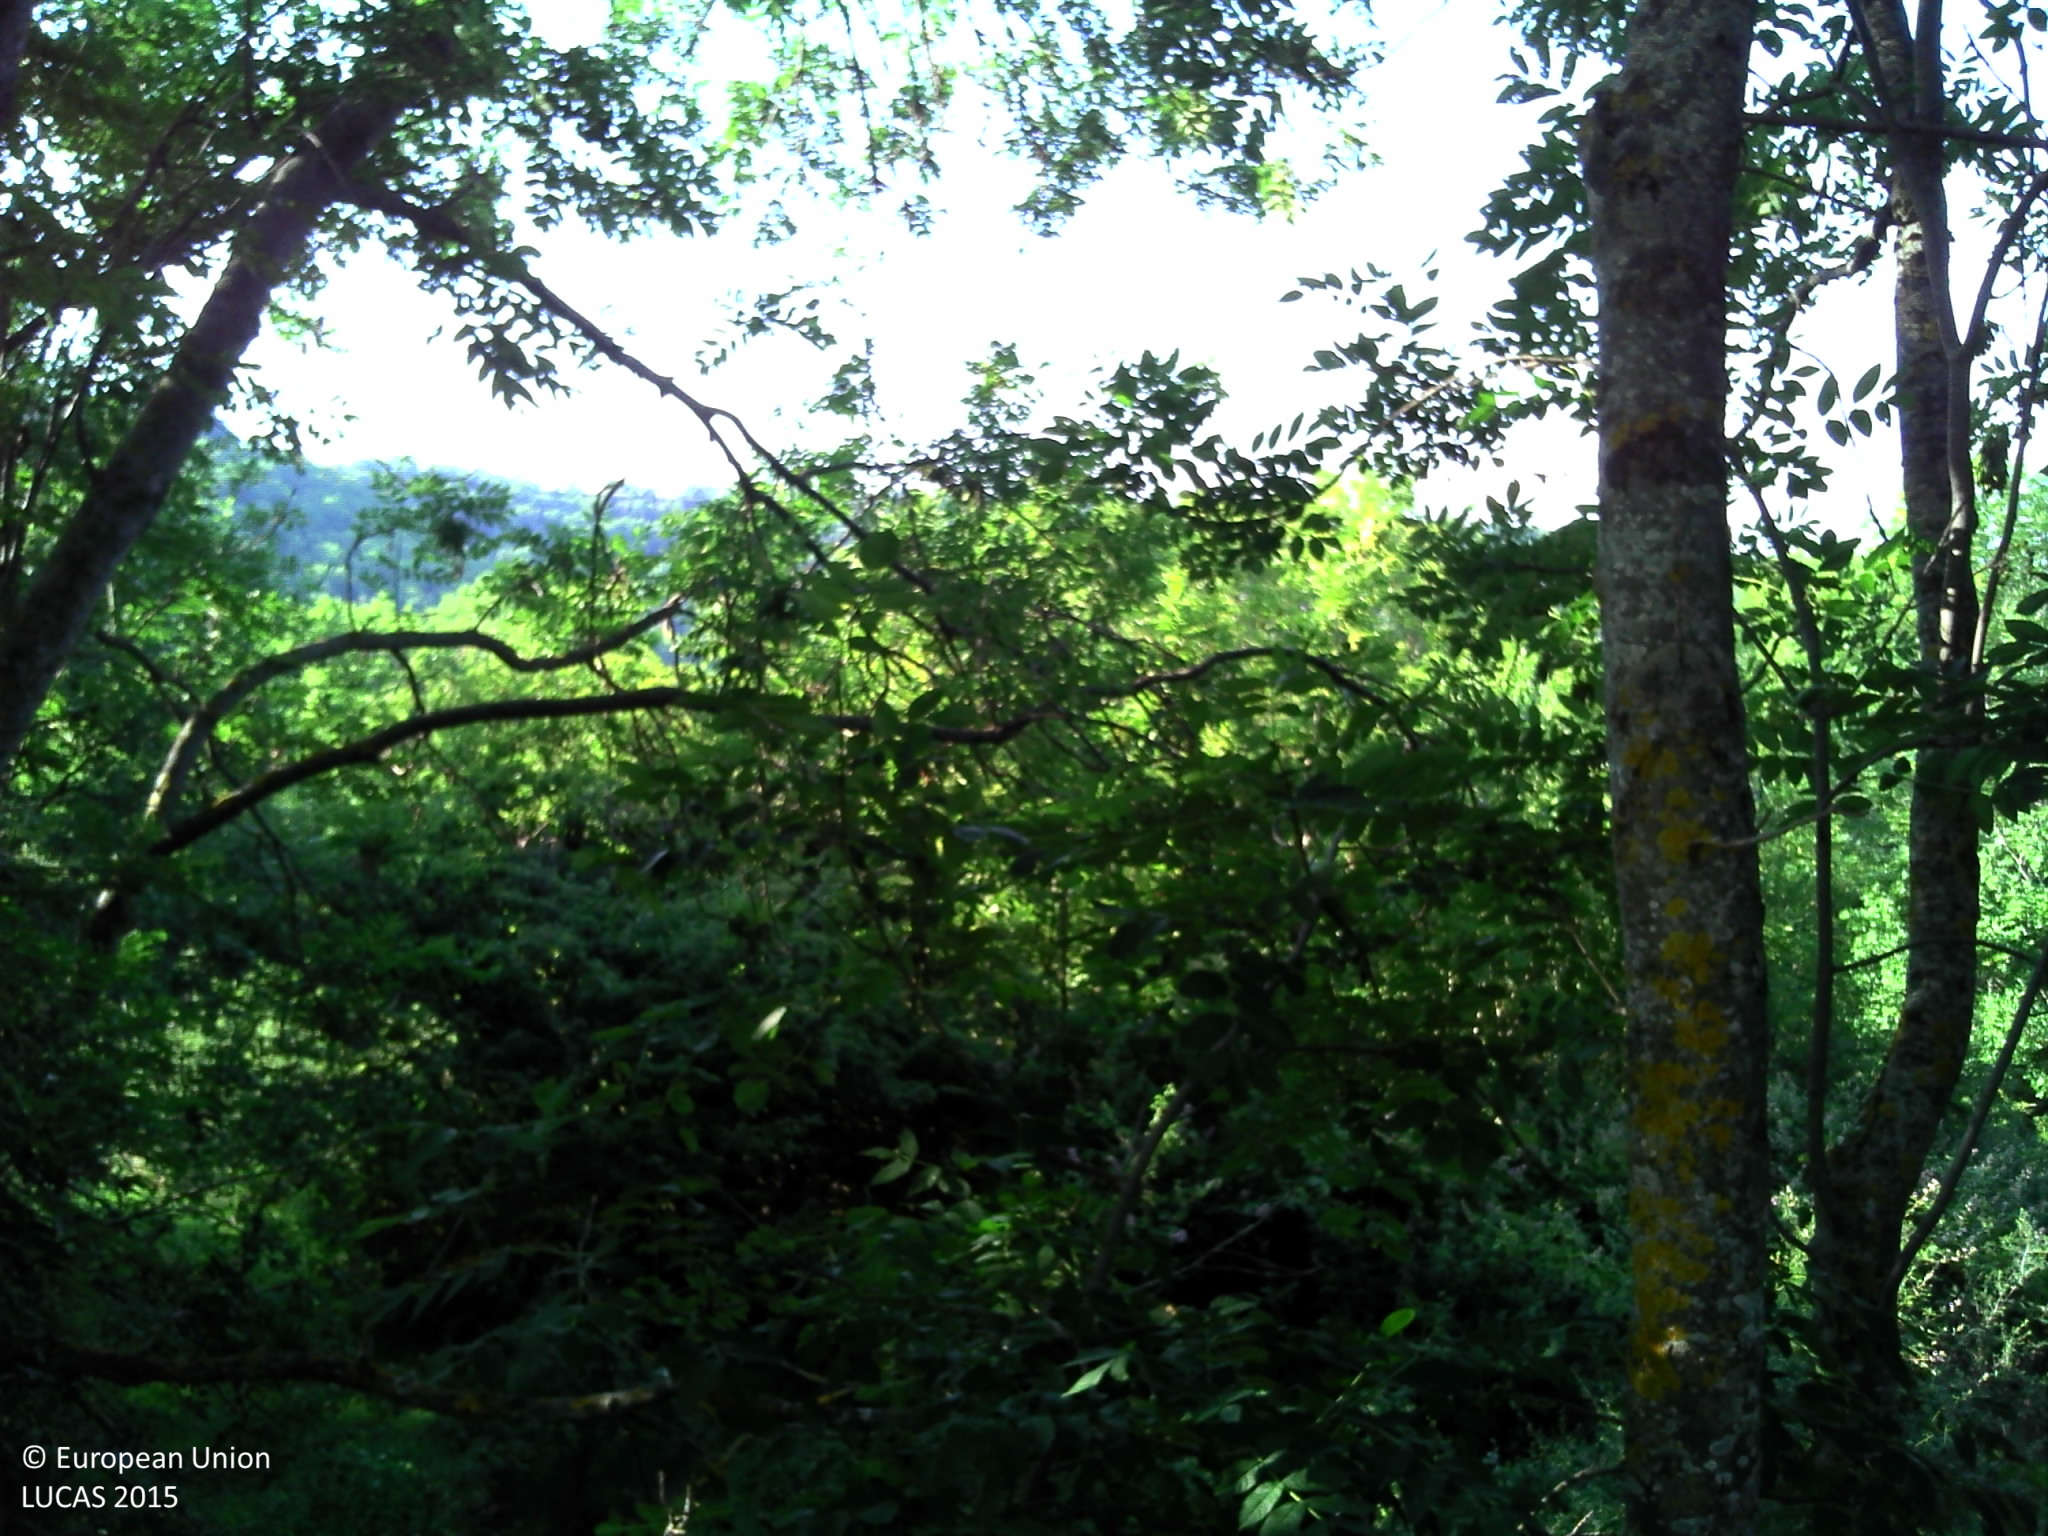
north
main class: Woodland
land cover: Broadleaved woodland
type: mesophytic deciduous forest
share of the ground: > 75 %
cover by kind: broadleaved forest trees 90 %, shrubs 5 %, herbaceous plants 5 %
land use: Forestry
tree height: > 5 m
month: July
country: FR
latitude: 45.4778
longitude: 3.1055
